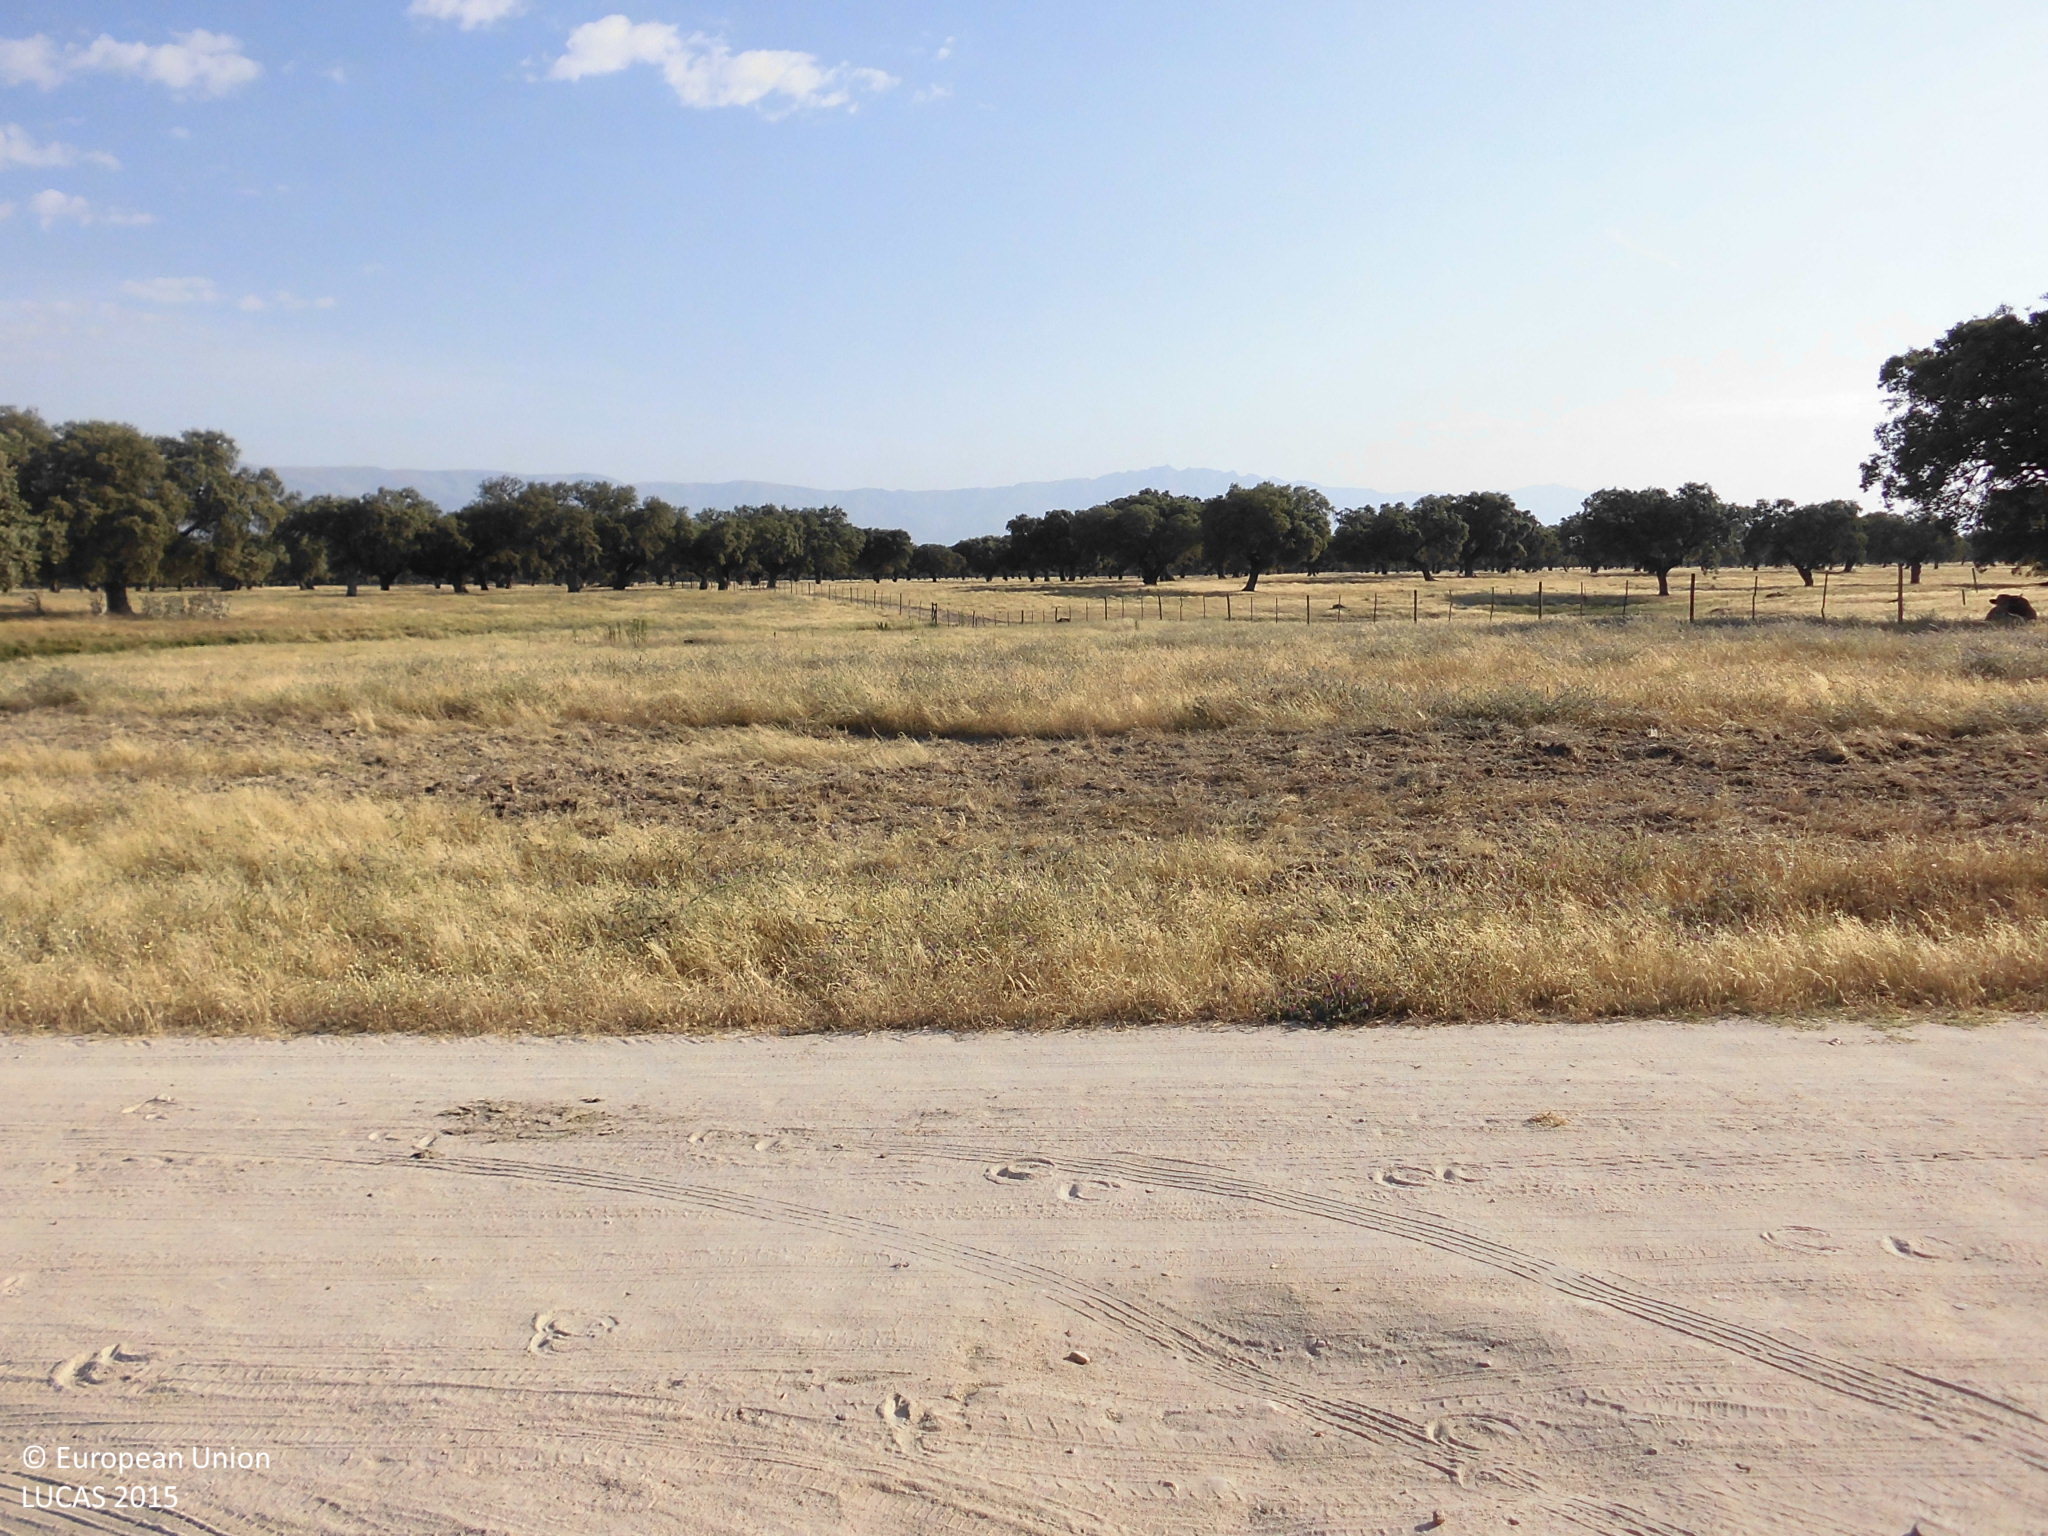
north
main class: Woodland
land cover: Broadleaved woodland
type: broadleaved evergreen forest
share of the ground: 25 - 50 %
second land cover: Grassland without tree/shrub cover
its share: > 75 %
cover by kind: herbaceous plants 70 %, broadleaved forest trees 30 %
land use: Forestry
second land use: Agriculture (excluding fallow land and kitchen gardens)
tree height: > 5 m
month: June
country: ES
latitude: 39.9578
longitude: -5.4279
